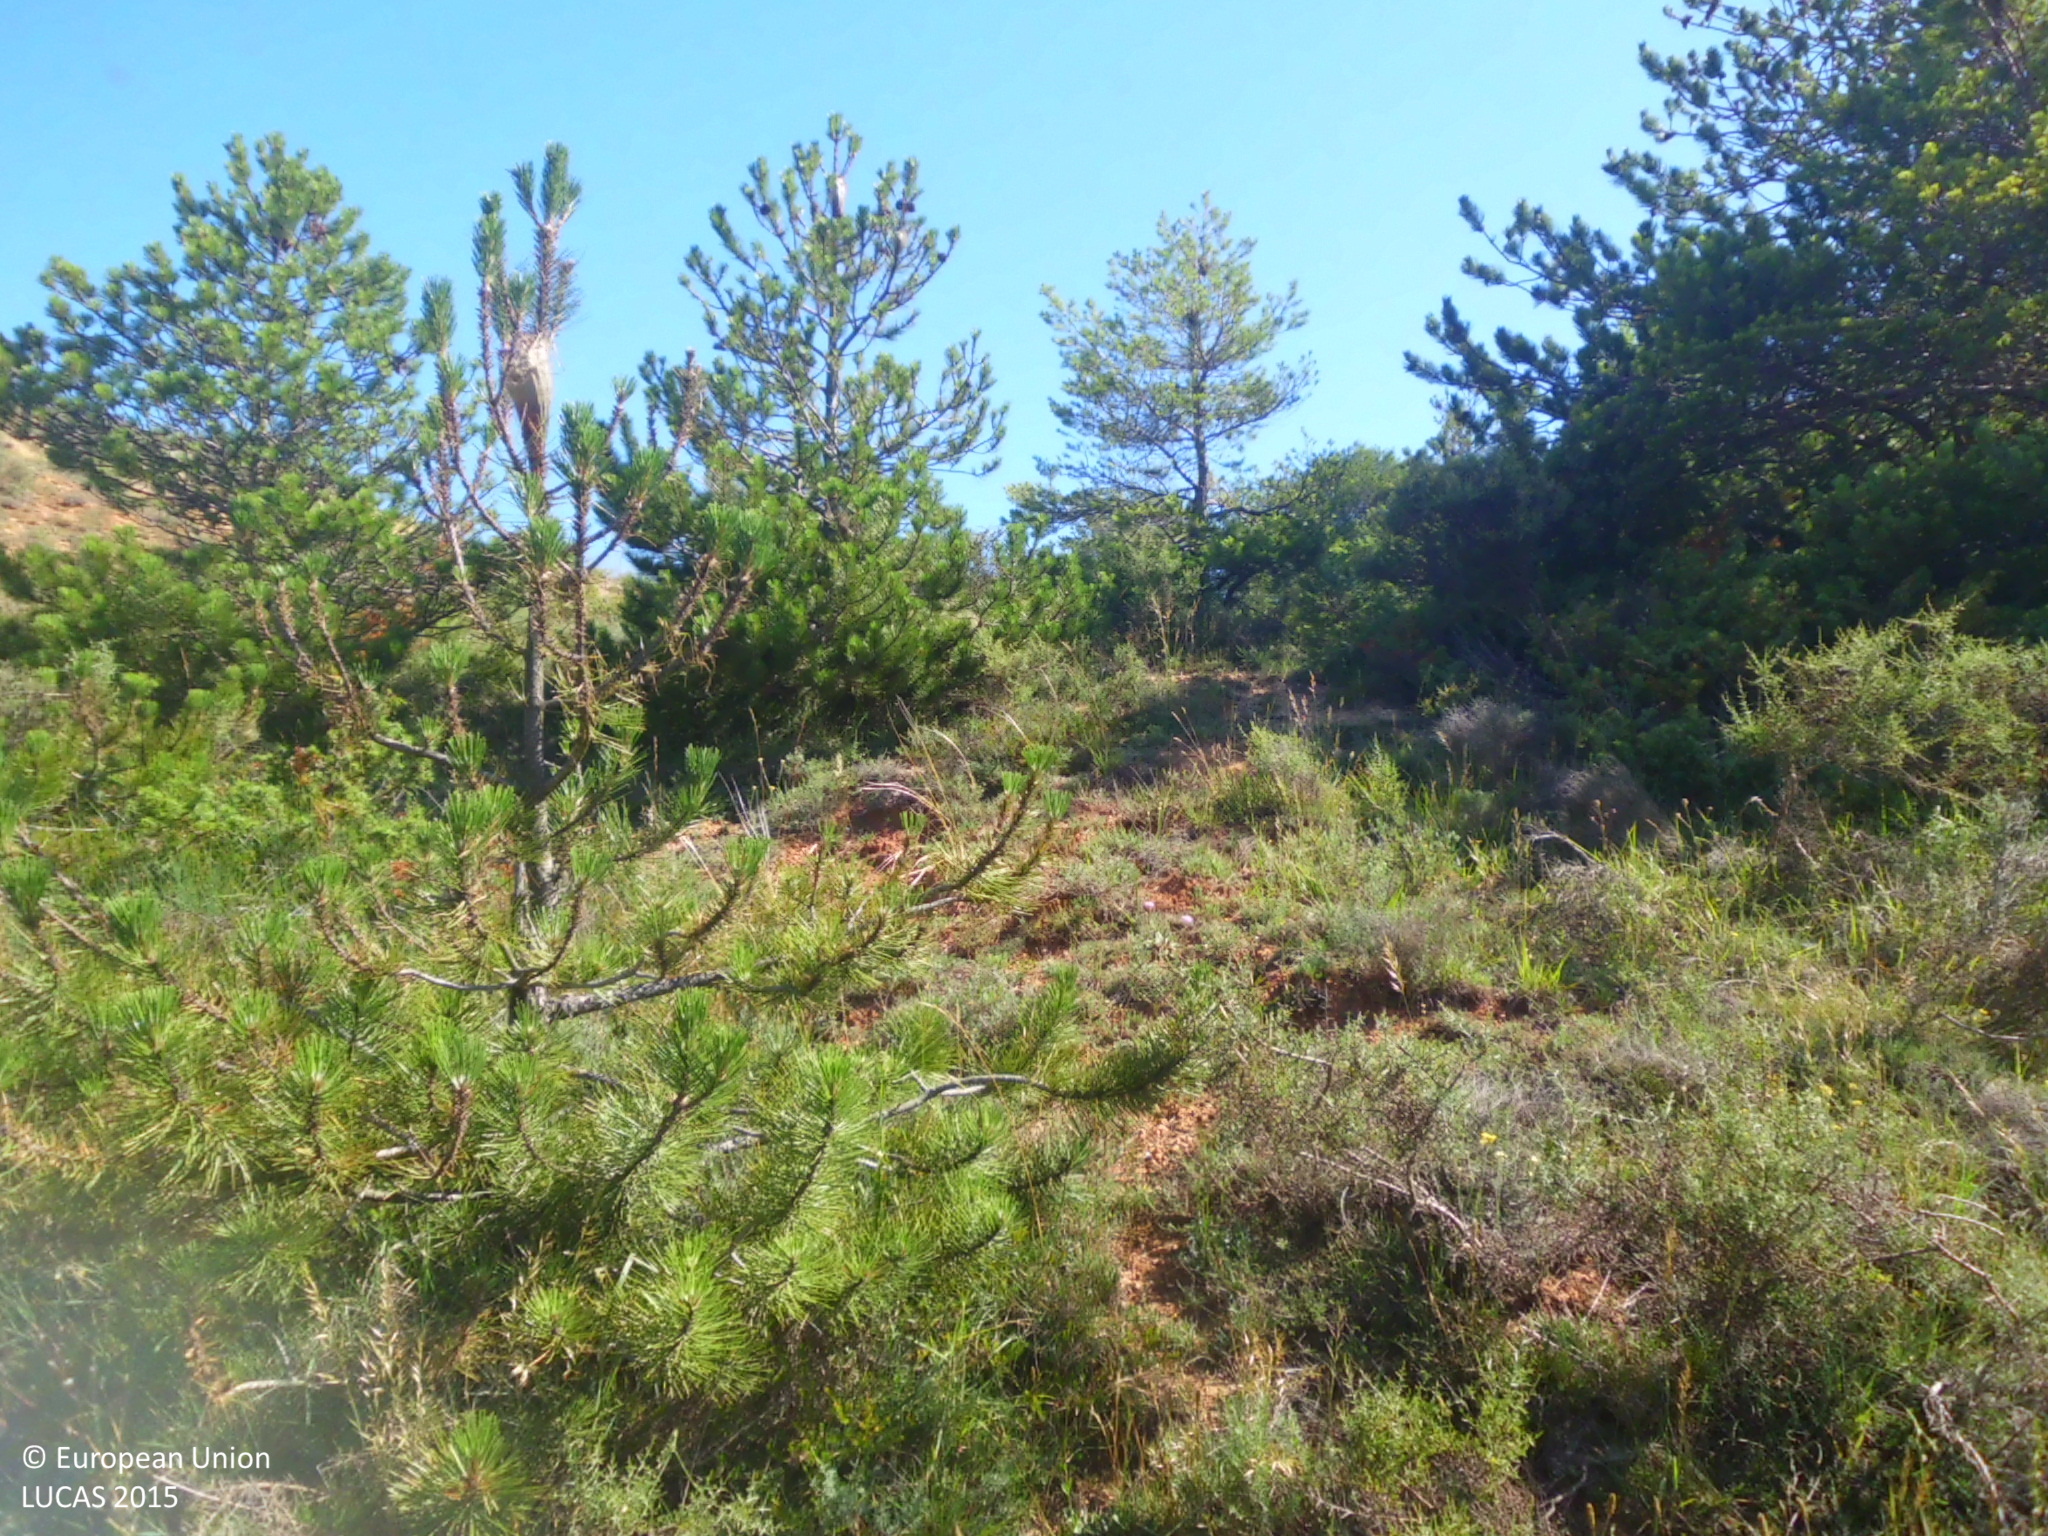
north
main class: Shrubland
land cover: Shrubland with sparse tree cover
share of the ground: 25 - 50 %
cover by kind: herbaceous plants 55 %, shrubs 30 %, consolidated bare surface 10 %, coniferous forest trees 5 %
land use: Semi-natural and natural areas not in use
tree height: < 5 m
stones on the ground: 10 - 25 %
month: June
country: ES
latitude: 42.9218
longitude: -3.4535
